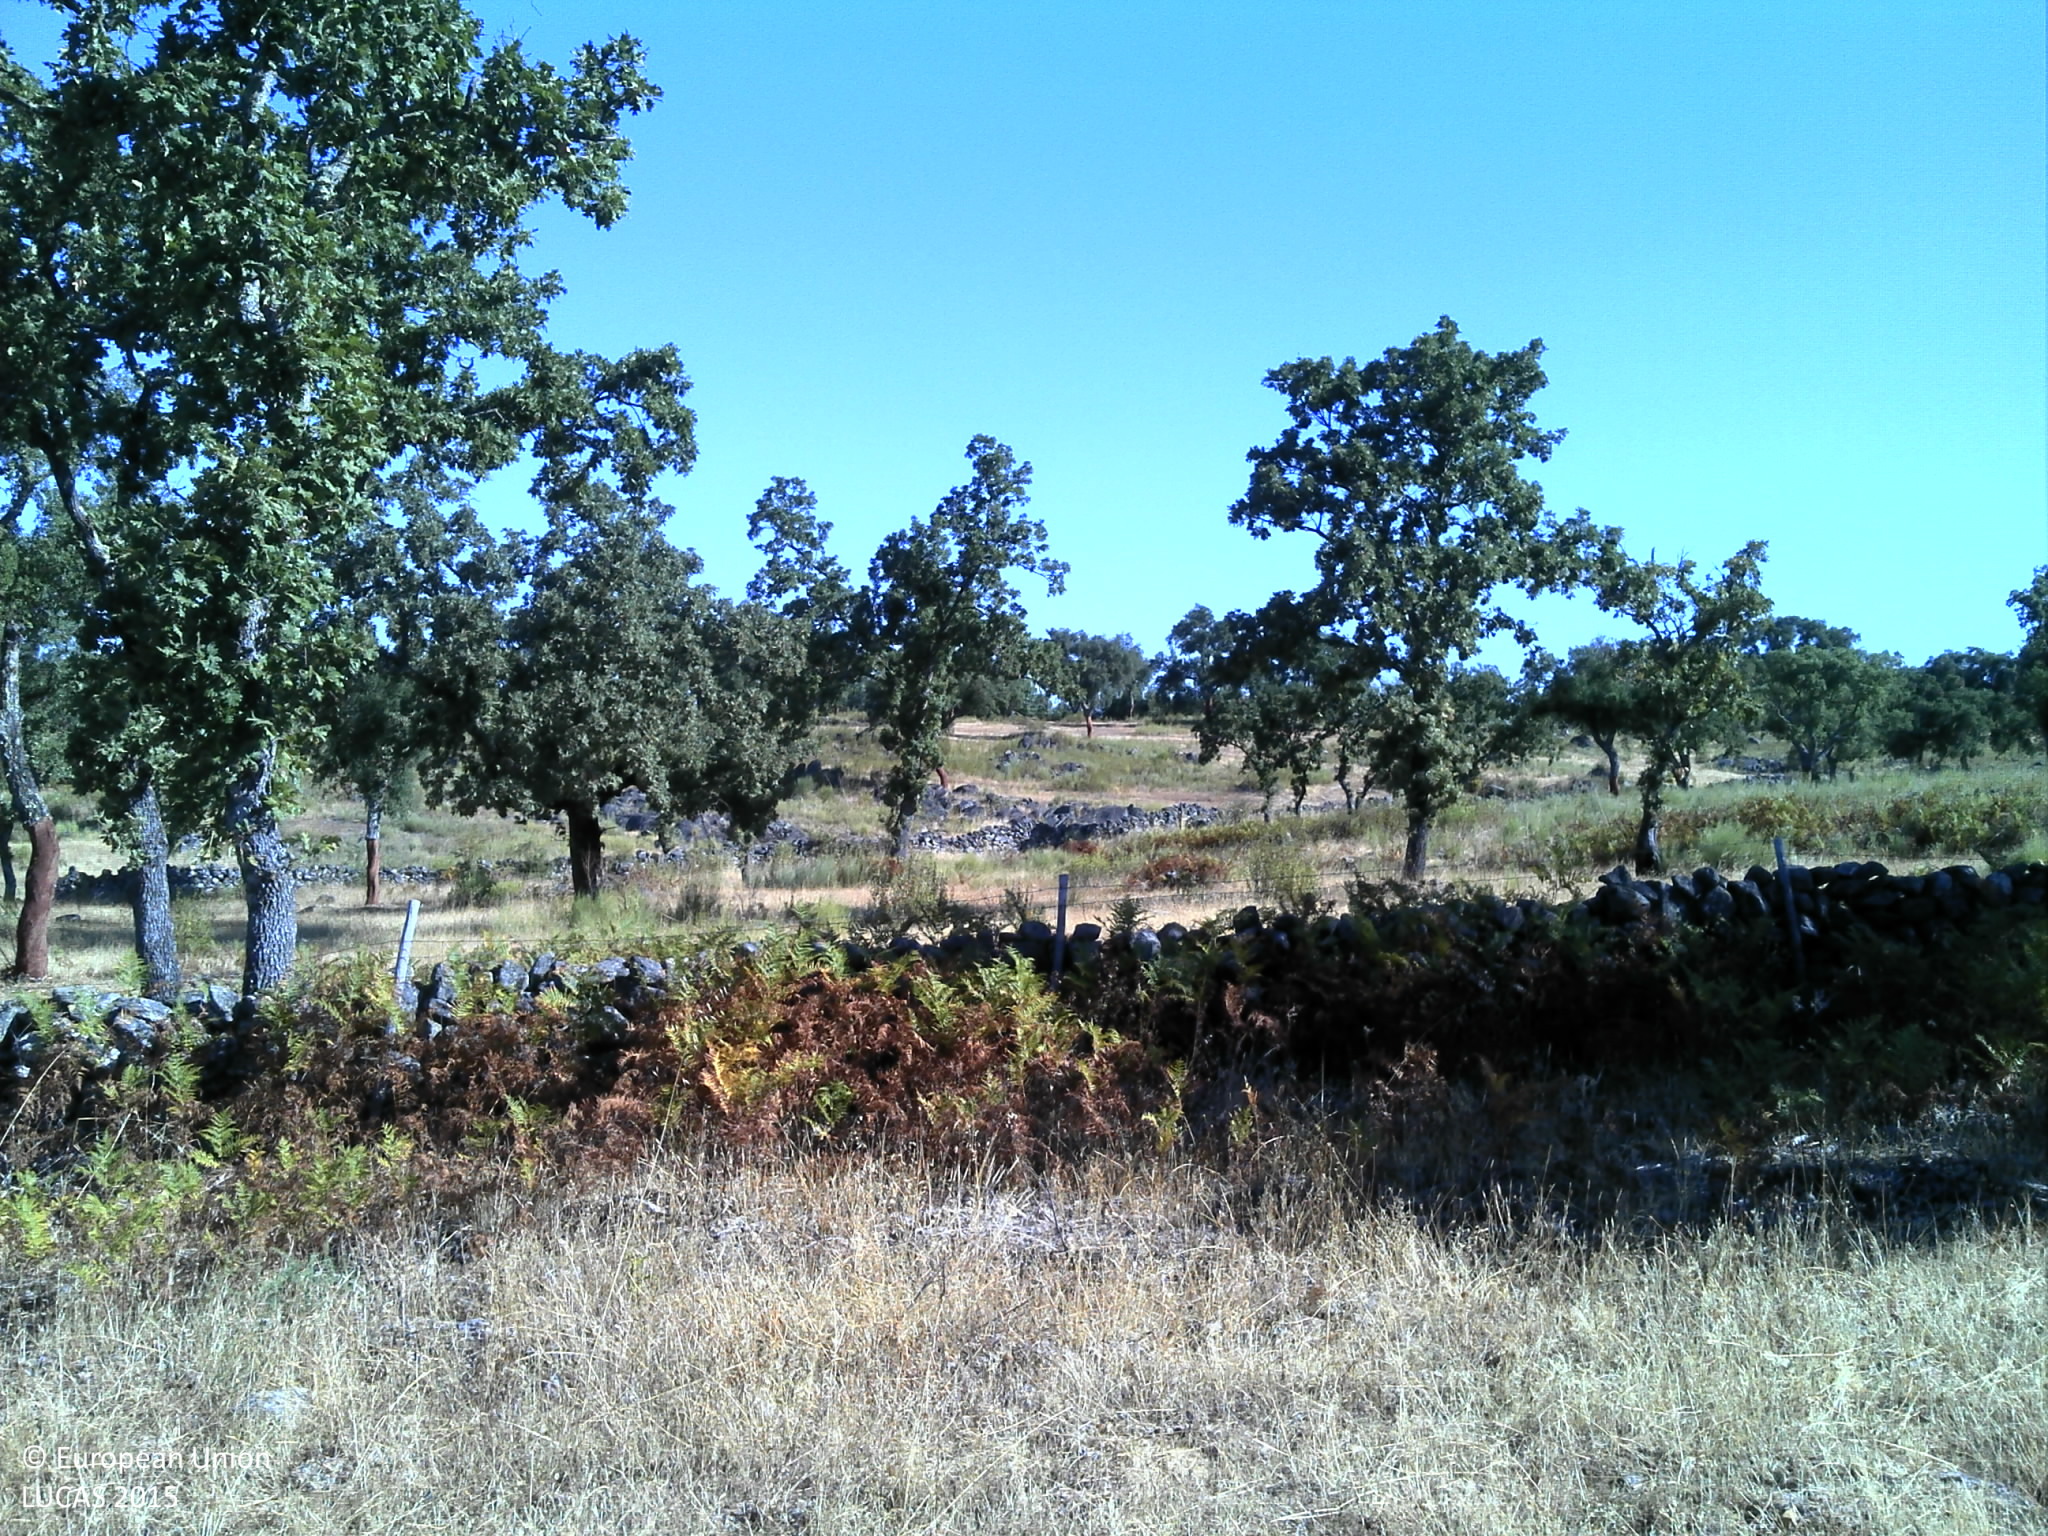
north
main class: Woodland
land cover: Broadleaved woodland
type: broadleaved evergreen forest
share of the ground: 10 - 25 %
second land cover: Grassland without tree/shrub cover
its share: 50 - 75 %
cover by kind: herbaceous plants 60 %, broadleaved forest trees 15 %, unconsolidated bare surface 15 %, consolidated bare surface 10 %
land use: Forestry
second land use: Agriculture (excluding fallow land and kitchen gardens)
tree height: > 5 m
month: August
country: PT
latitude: 39.3833
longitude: -7.4937
